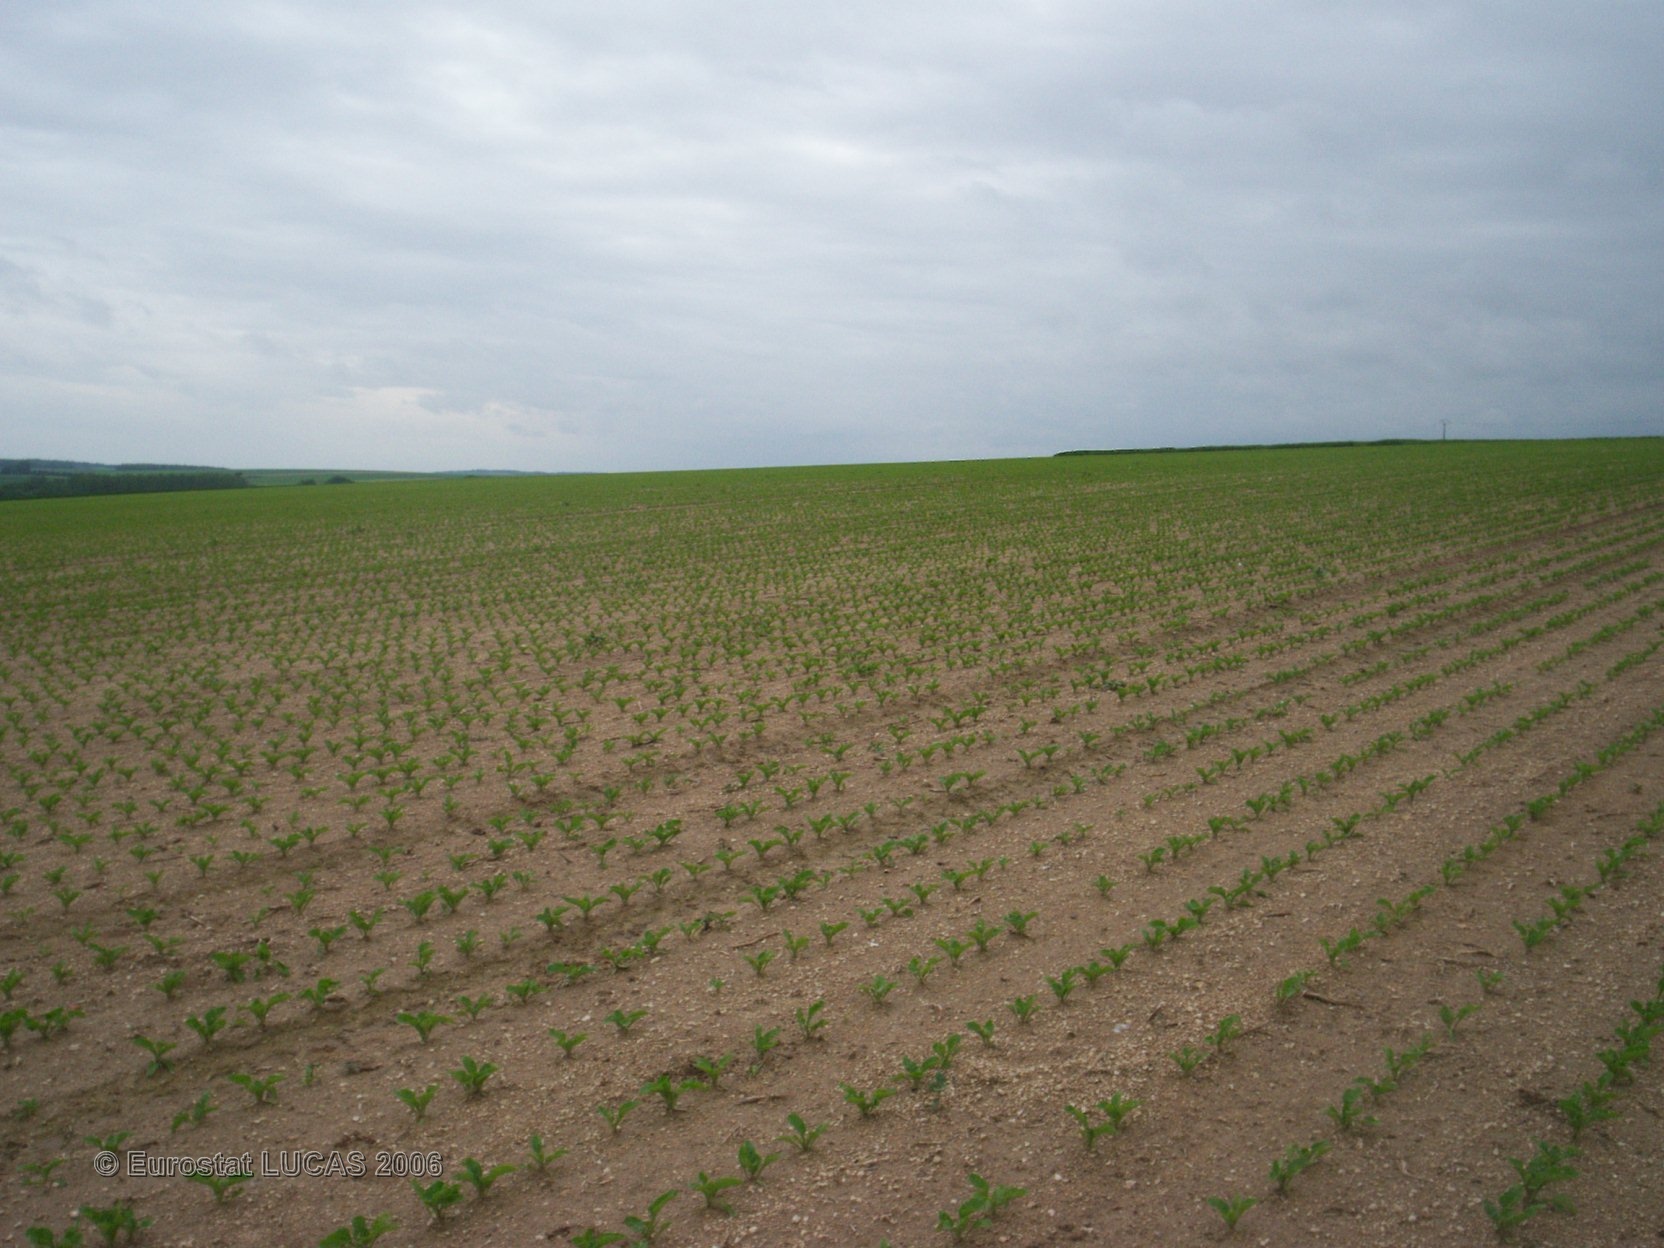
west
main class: Cropland
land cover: Sugar beet
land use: Agriculture (excluding fallow land and kitchen gardens)
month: May
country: FR
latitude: 49.4122
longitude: 4.3309
